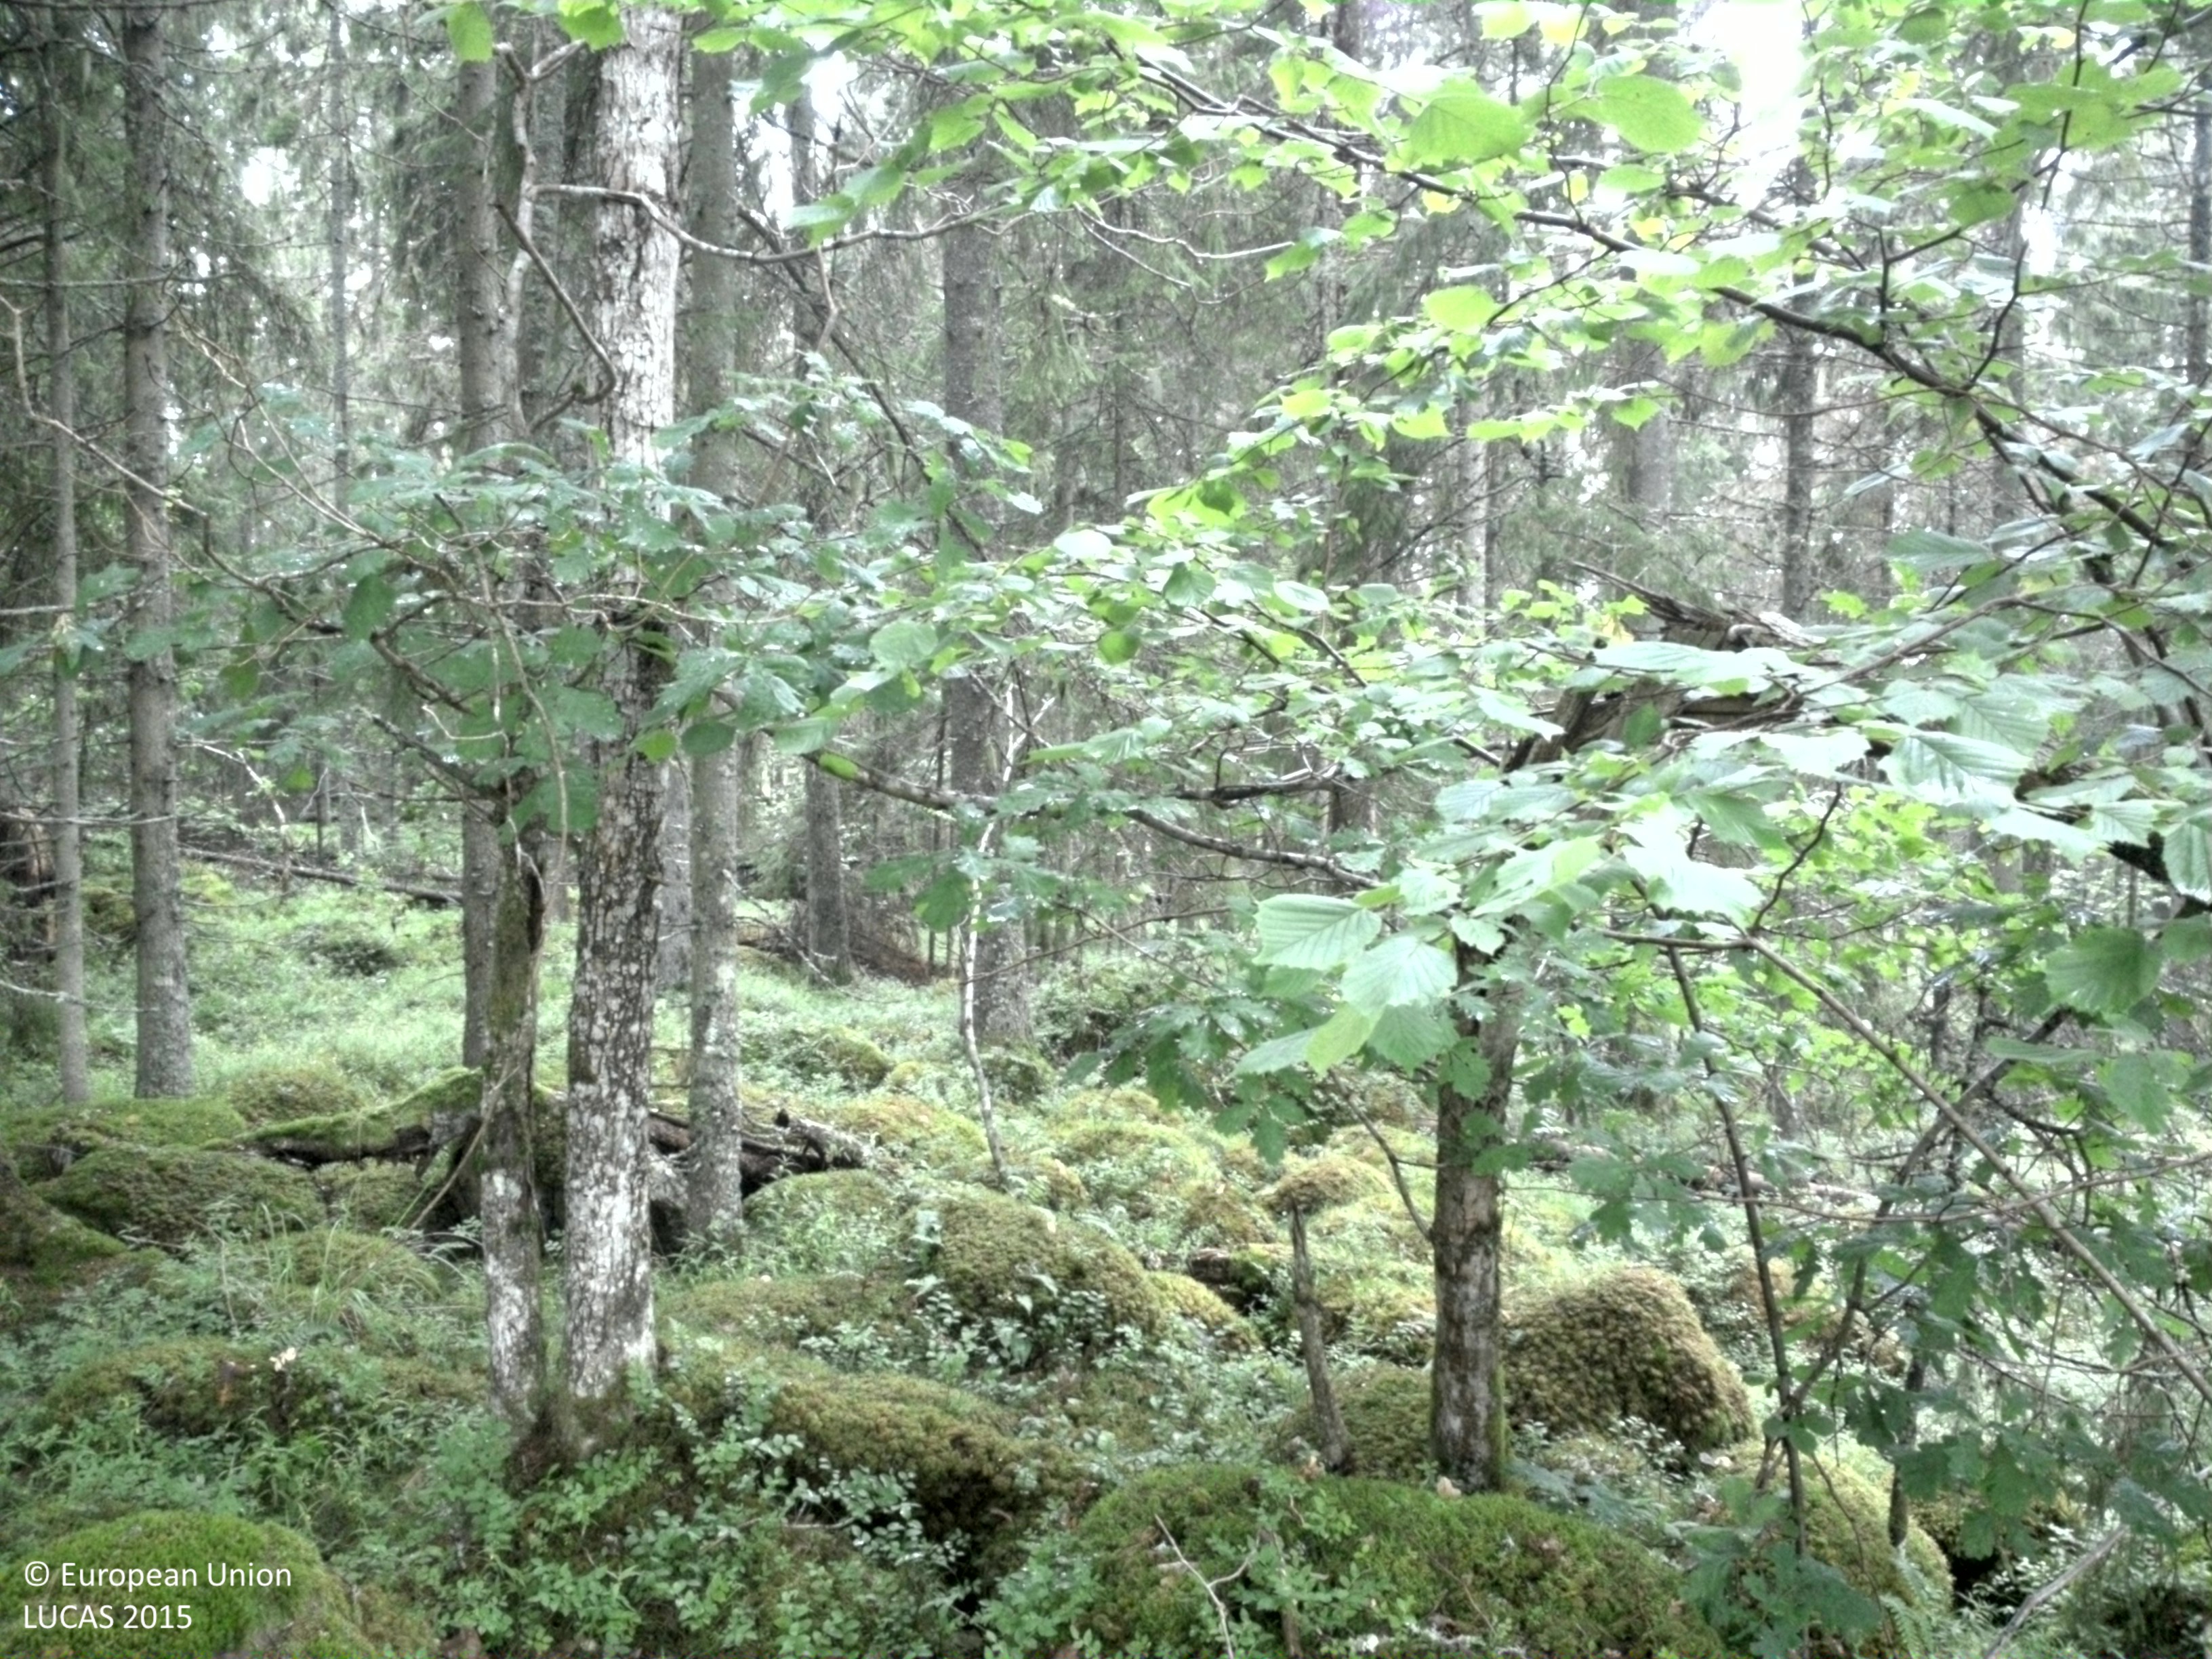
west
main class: Woodland
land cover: Spruce dominated coniferous woodland
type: boreal forest
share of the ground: 50 - 75 %
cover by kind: coniferous forest trees 55 %, shrubs 30 %, herbaceous plants 10 %, lichens and mosses 5 %
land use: Amenities, museums, leisure
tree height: > 5 m
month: July
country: SE
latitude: 59.8798
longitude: 18.6279
